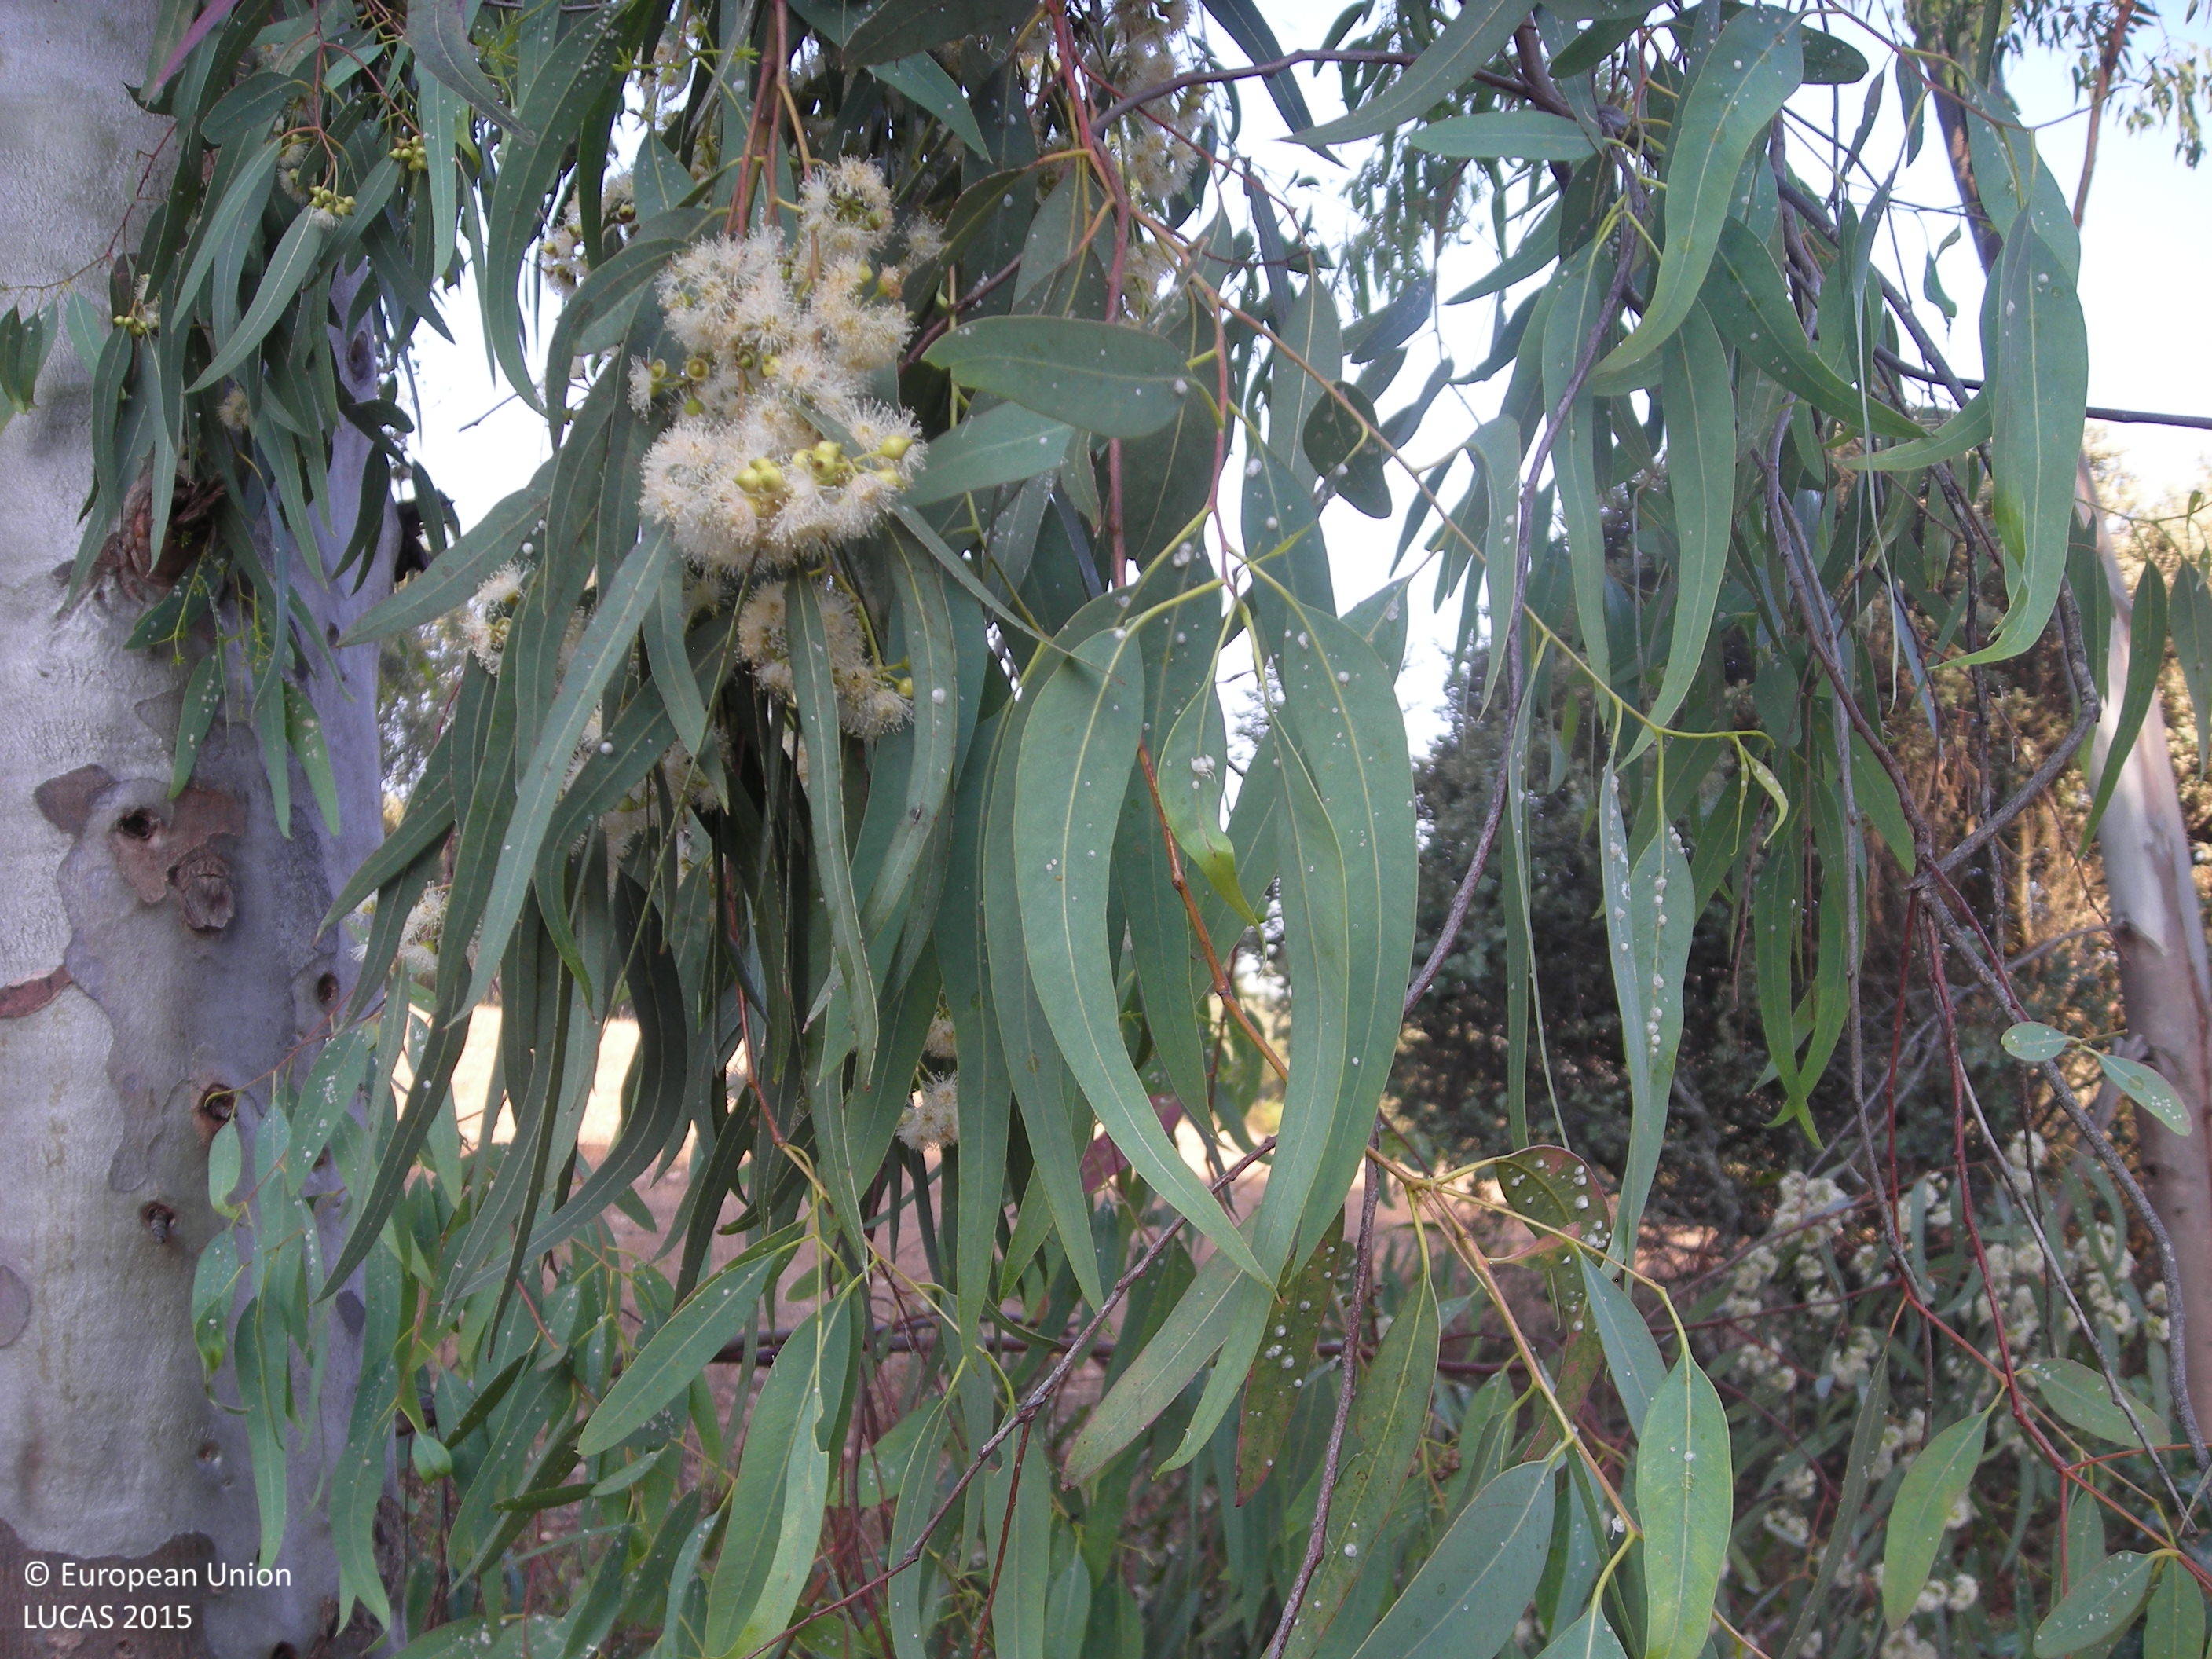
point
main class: Woodland
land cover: Broadleaved woodland
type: exotic forest
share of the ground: > 75 %
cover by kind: broadleaved forest trees 100 %
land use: Forestry
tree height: > 5 m
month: June
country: ES
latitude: 39.0504
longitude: -5.4699
